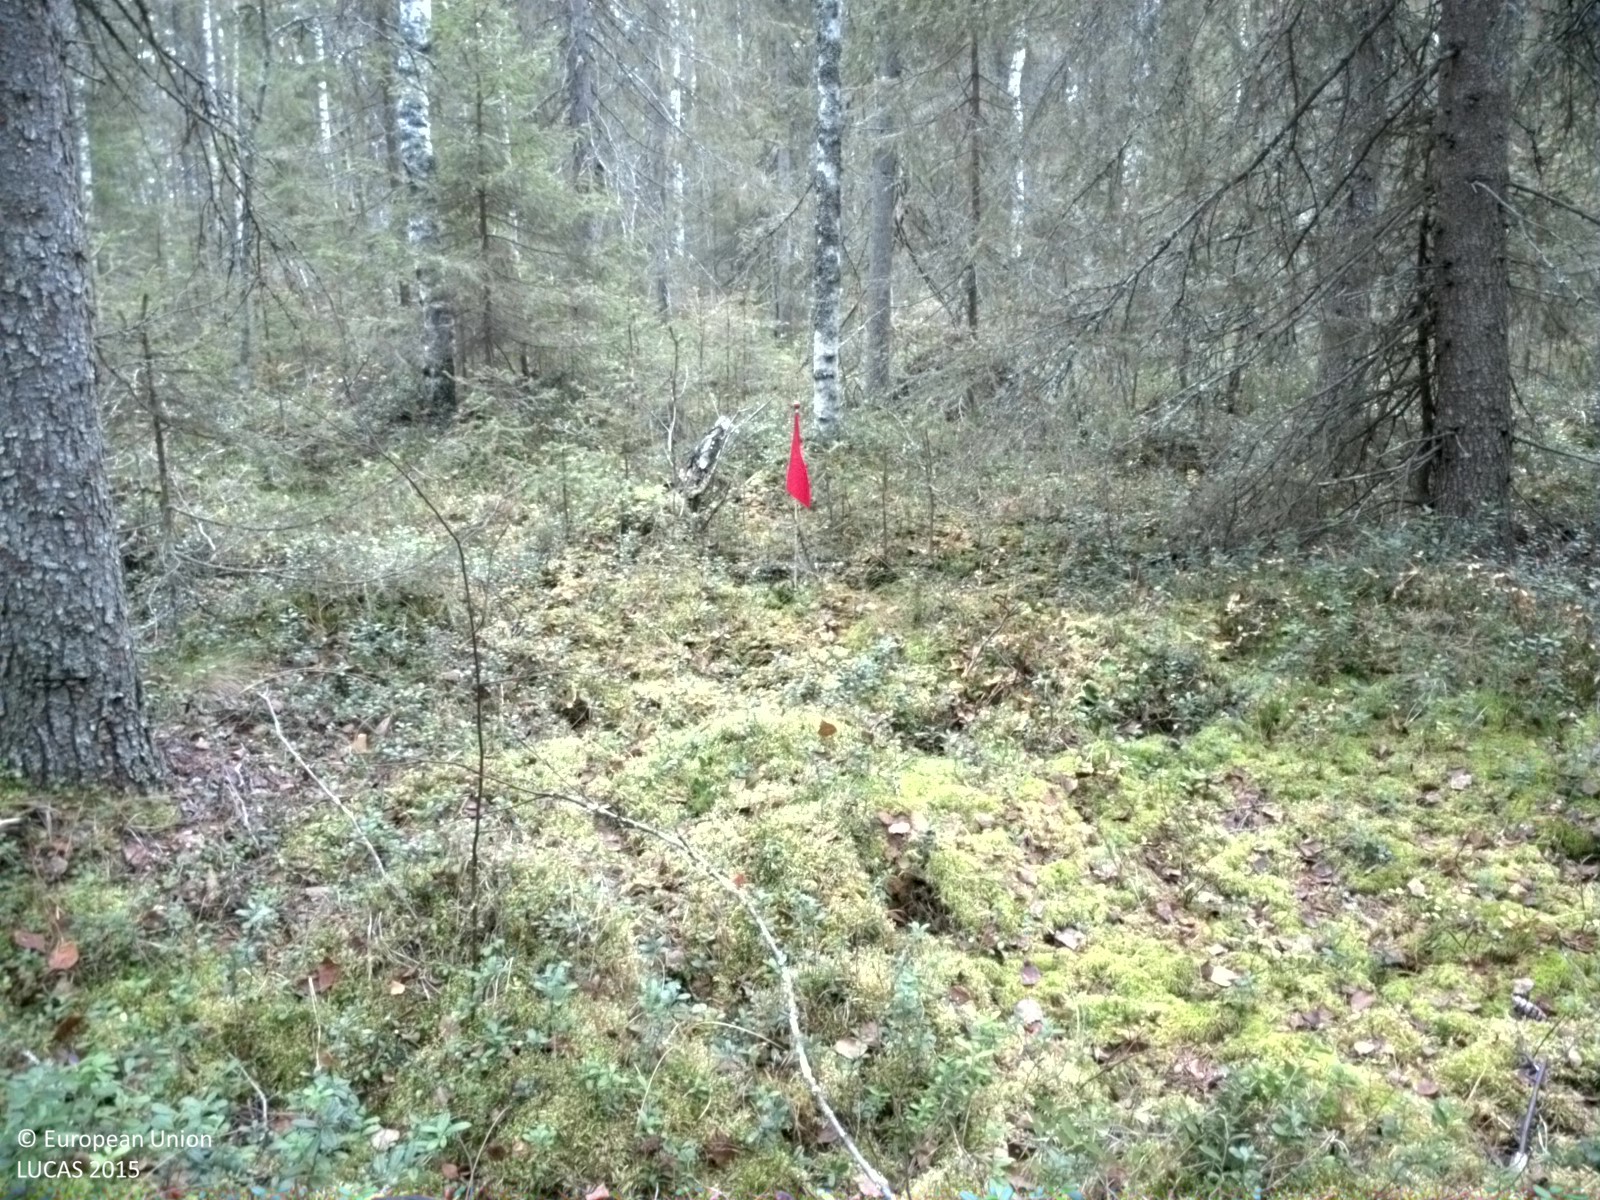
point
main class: Woodland
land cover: Spruce dominated mixed woodland
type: boreal forest
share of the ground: 50 - 75 %
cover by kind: coniferous forest trees 40 %, shrubs 40 %, broadleaved forest trees 15 %, lichens and mosses 5 %
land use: Forestry
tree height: > 5 m
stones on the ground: < 10 %
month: October
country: SE
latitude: 65.6577
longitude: 21.0358
